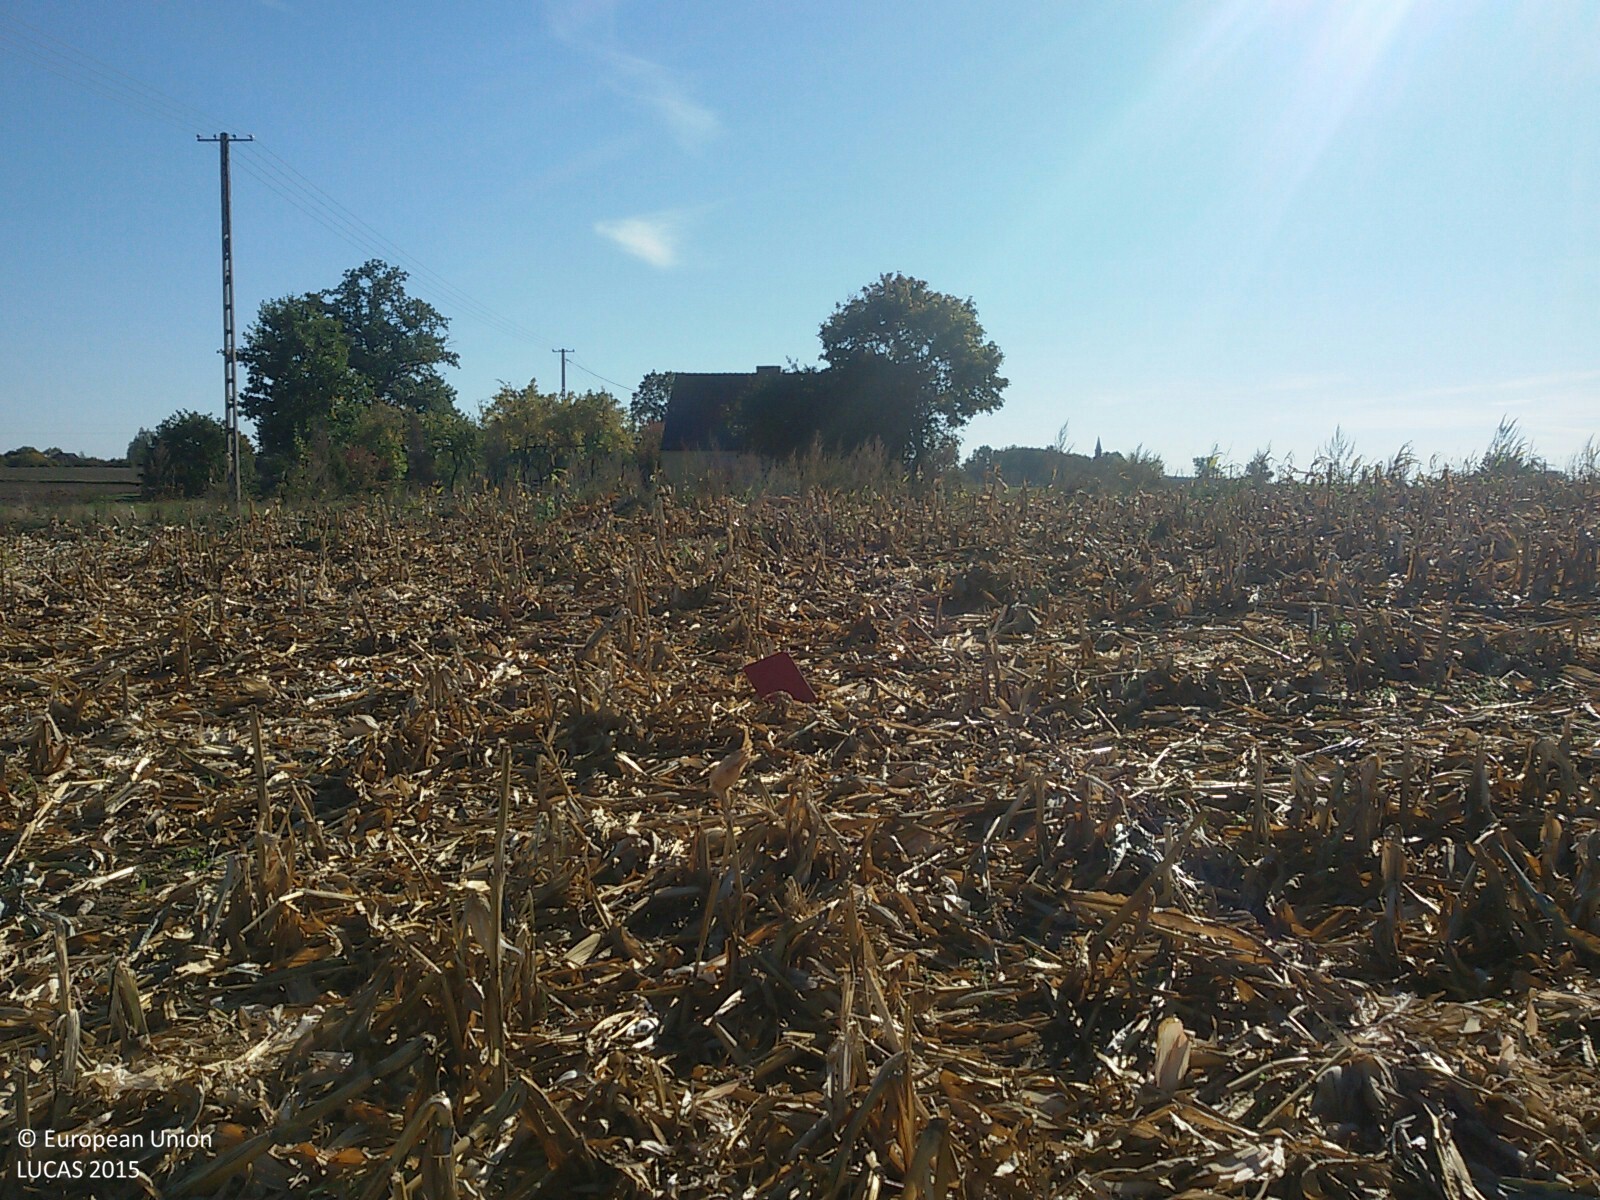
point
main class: Cropland
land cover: Maize
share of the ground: > 75 %
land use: Agriculture (excluding fallow land and kitchen gardens)
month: October
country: PL
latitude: 53.2516
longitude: 19.1817
